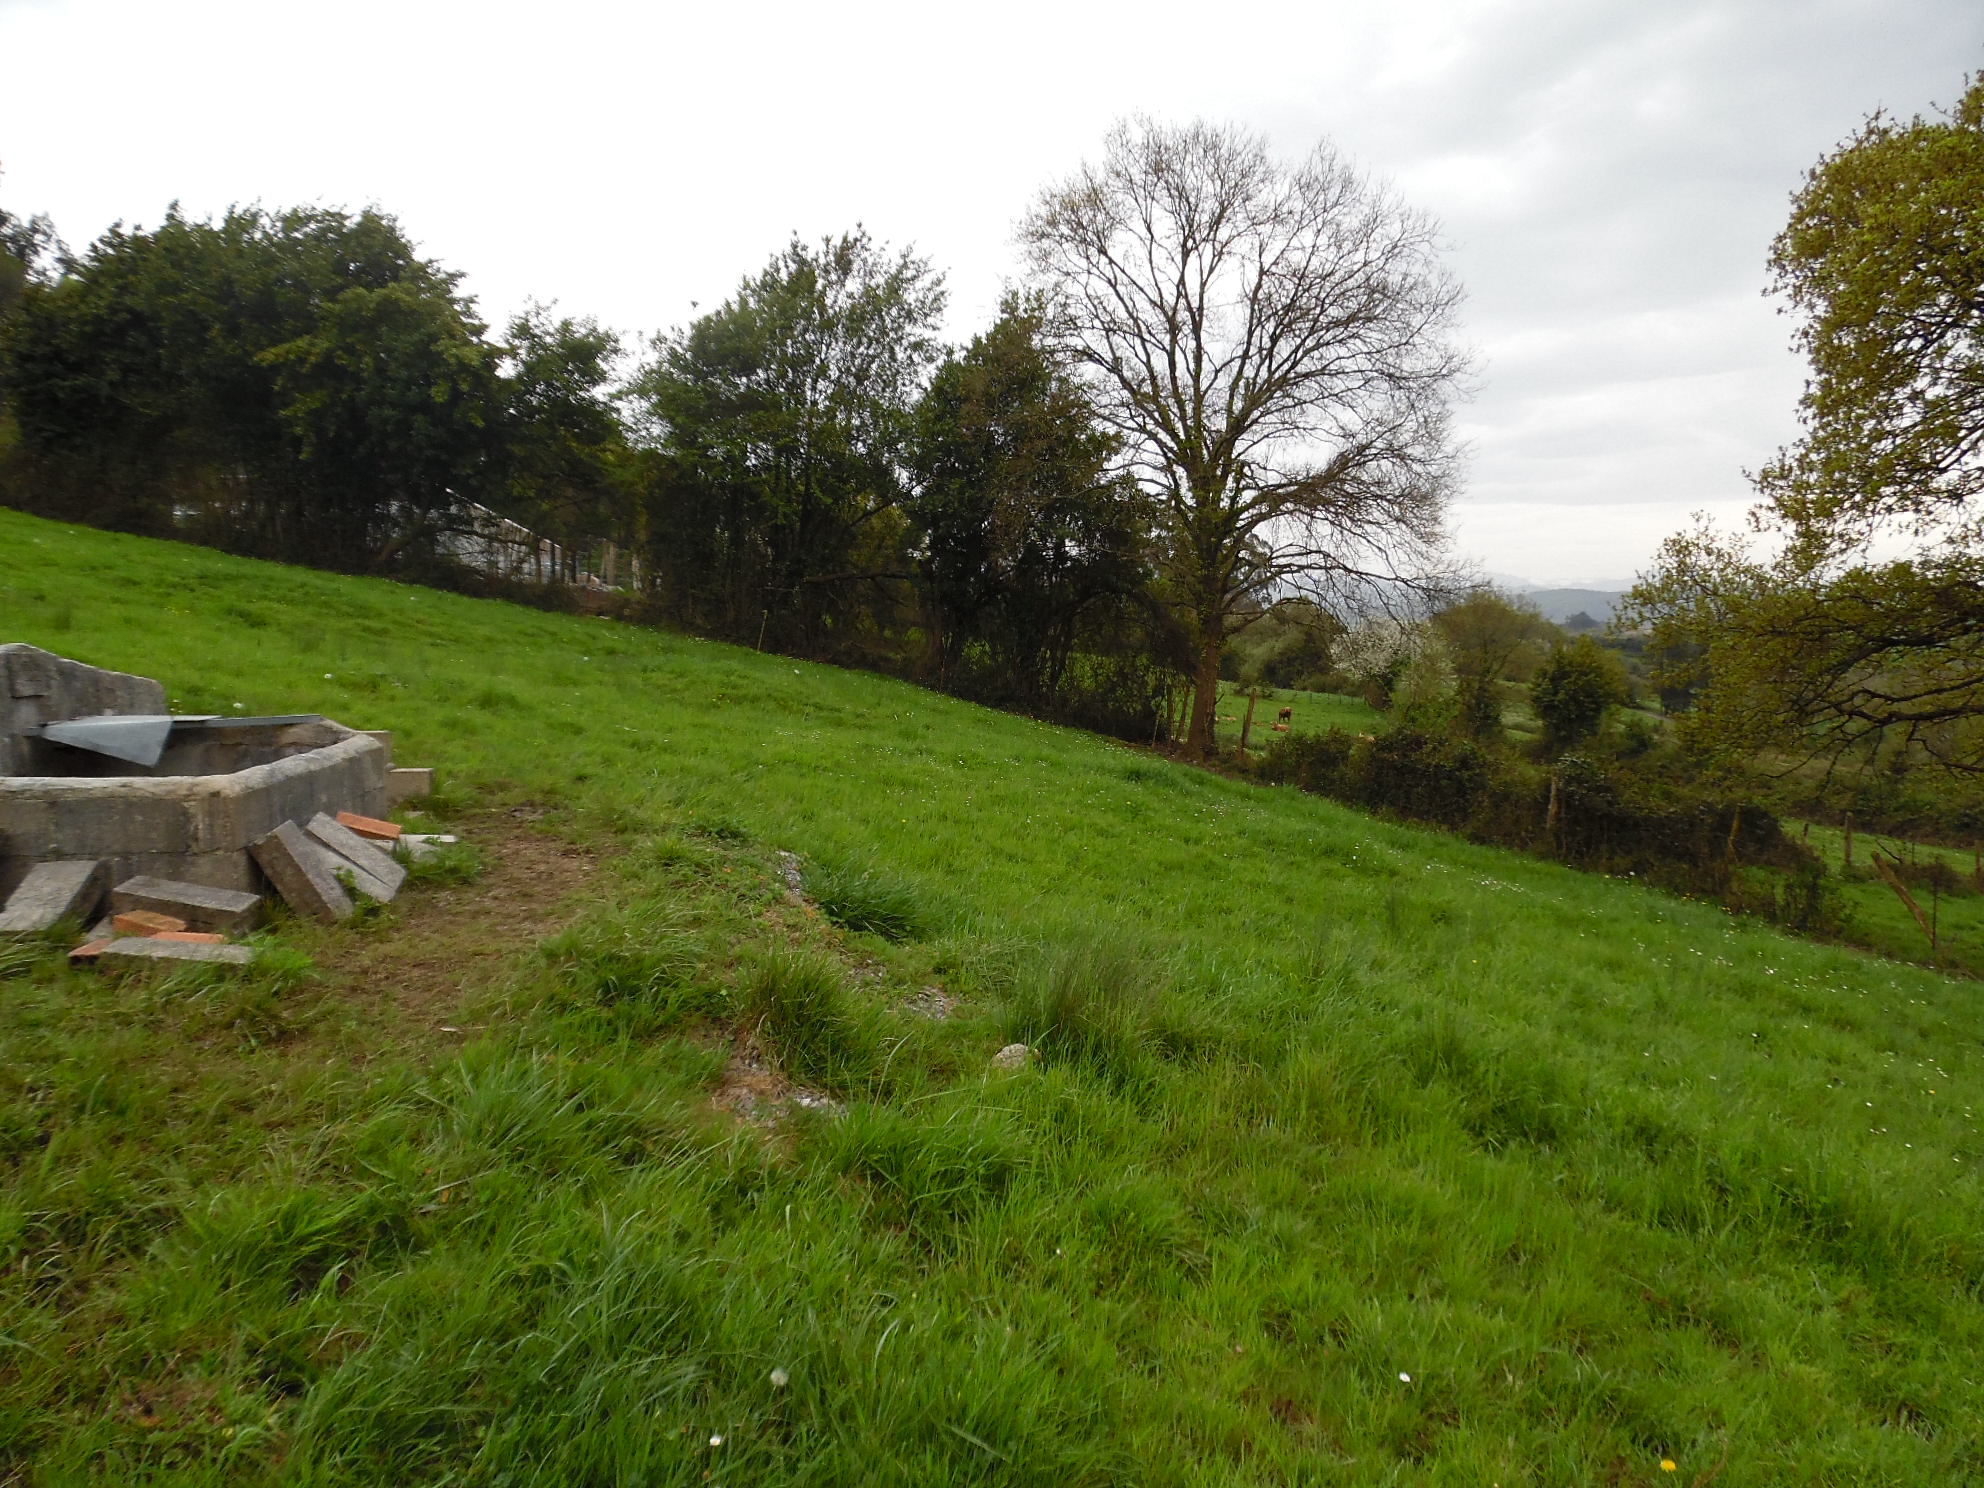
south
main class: Grassland
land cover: Grassland without tree/shrub cover
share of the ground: > 75 %
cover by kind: herbaceous plants 100 %
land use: Agriculture (excluding fallow land and kitchen gardens)
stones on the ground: < 10 %
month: April
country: ES
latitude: 43.4214
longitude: -5.5836
